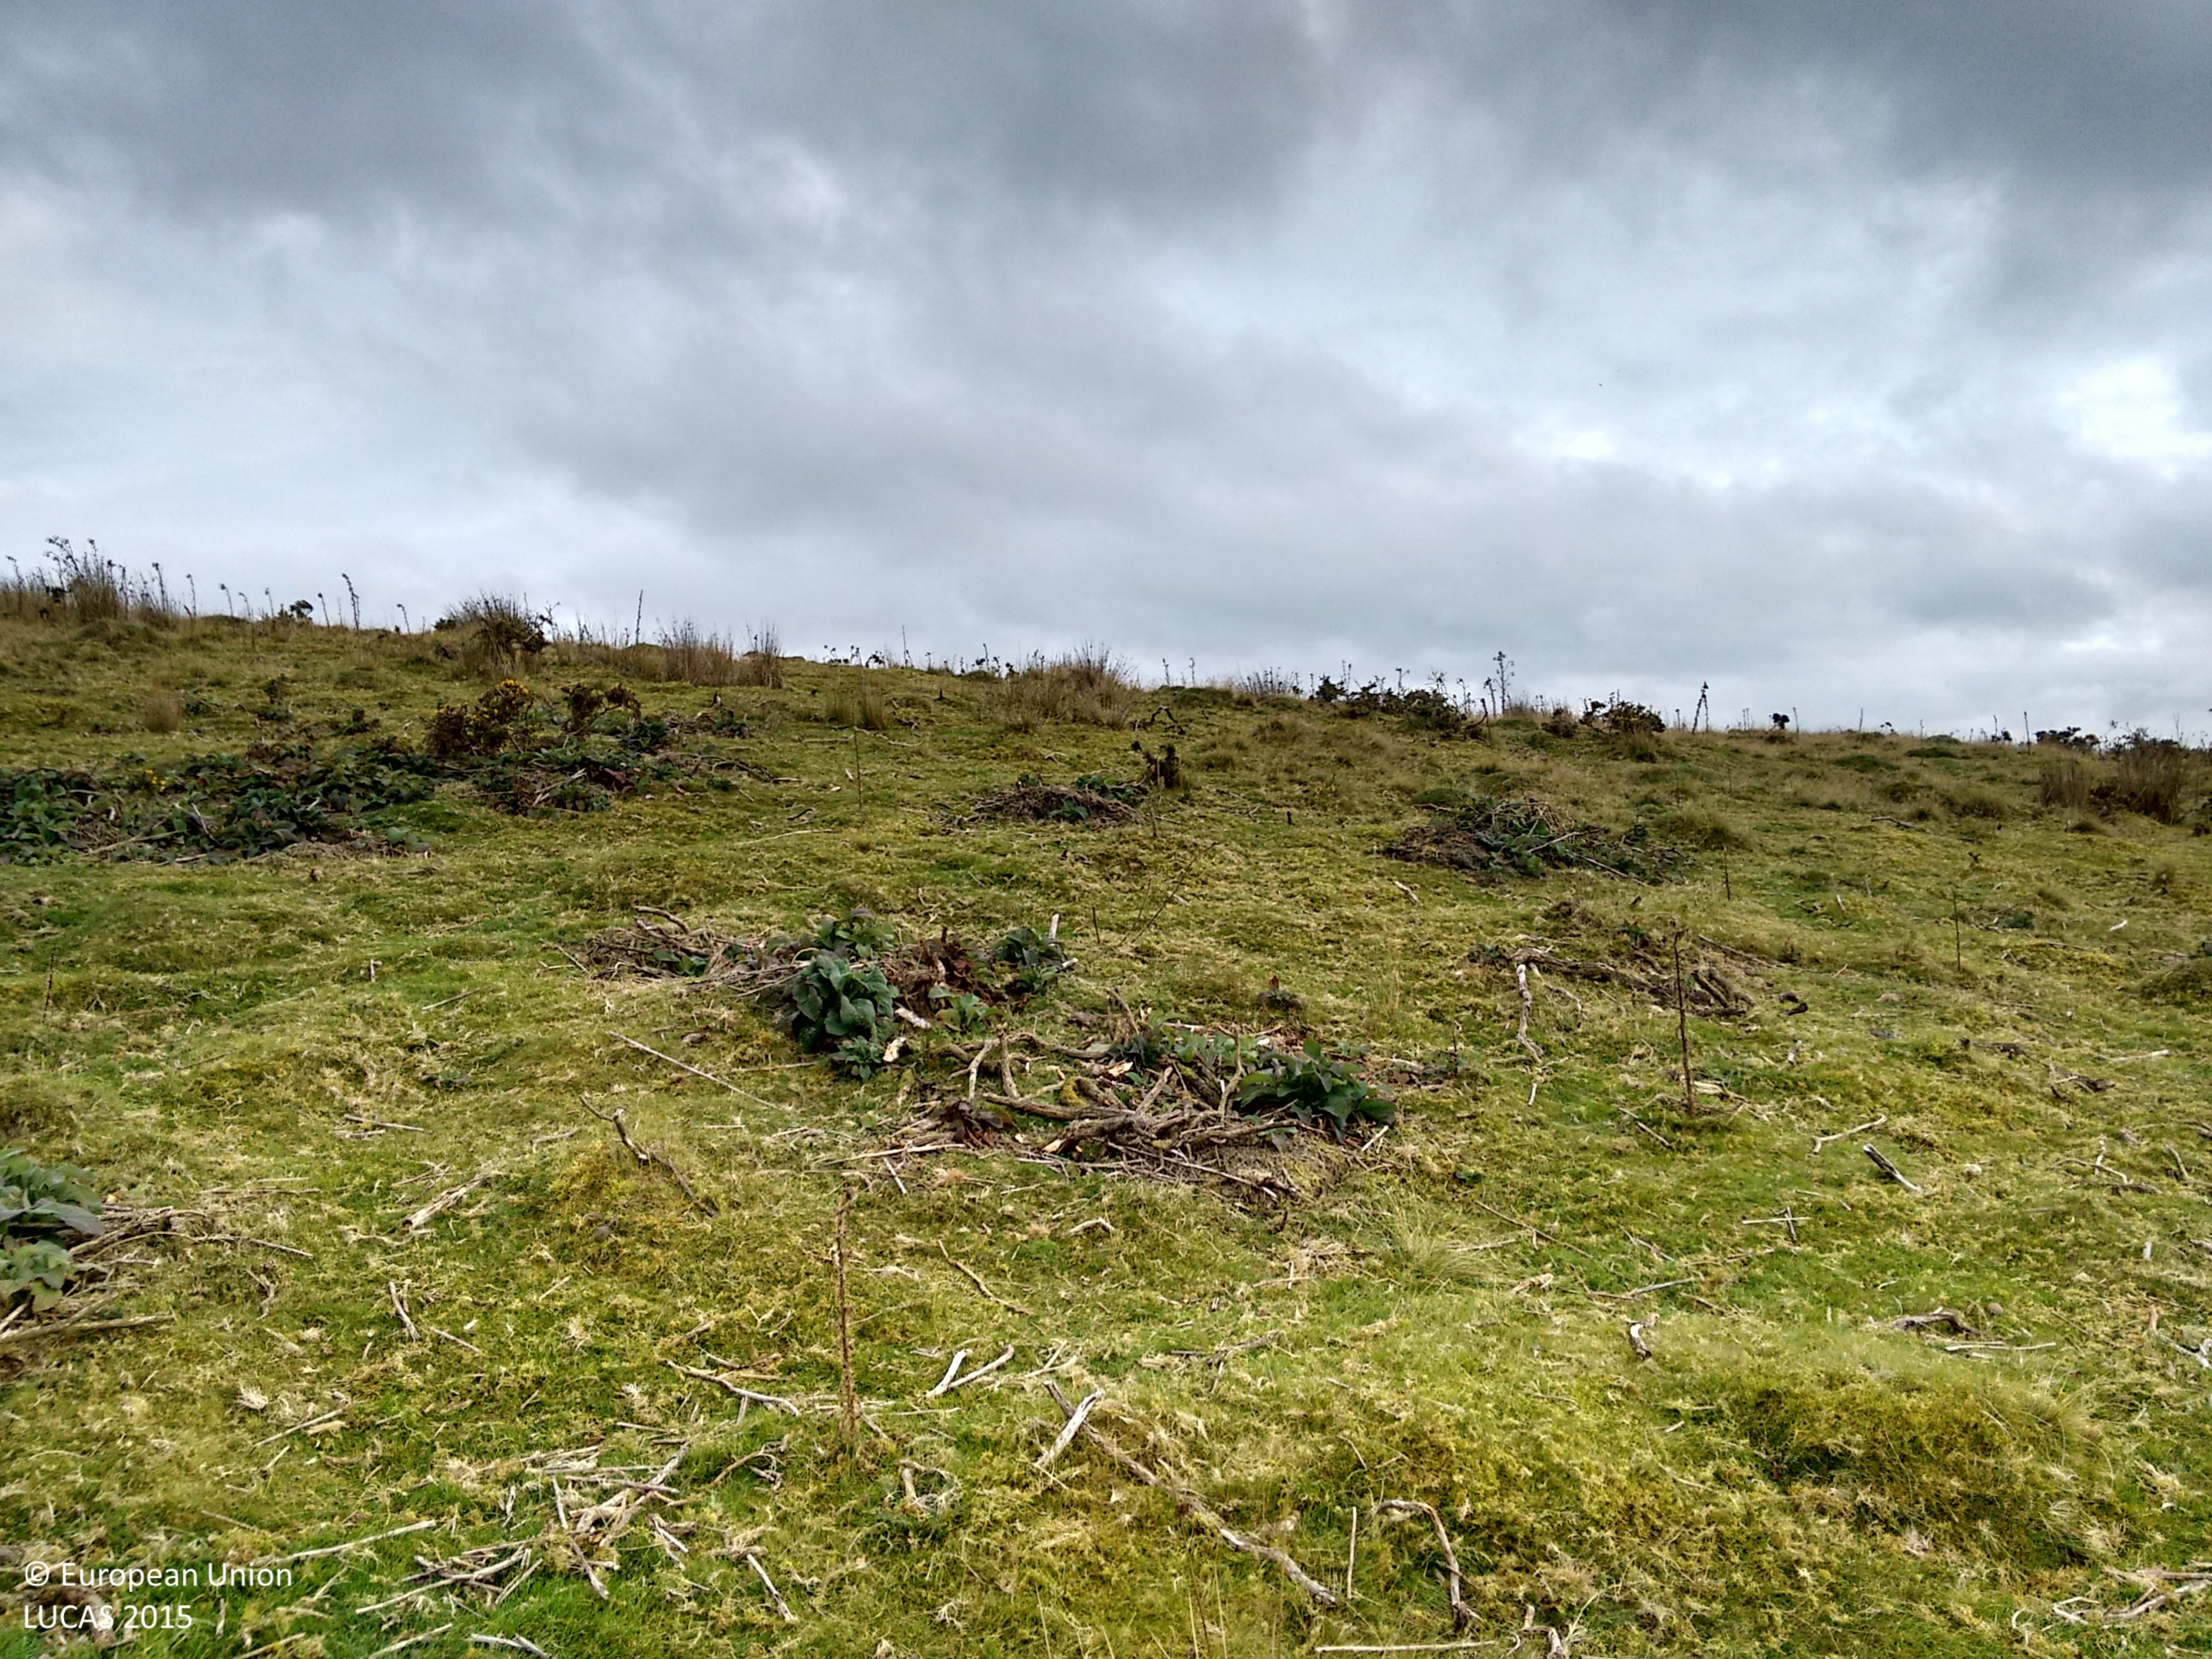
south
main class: Grassland
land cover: Grassland without tree/shrub cover
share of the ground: > 75 %
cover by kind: herbaceous plants 90 %, shrubs 5 %, lichens and mosses 5 %
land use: Agriculture (excluding fallow land and kitchen gardens)
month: October
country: GB
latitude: 52.2649
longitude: -3.2823
